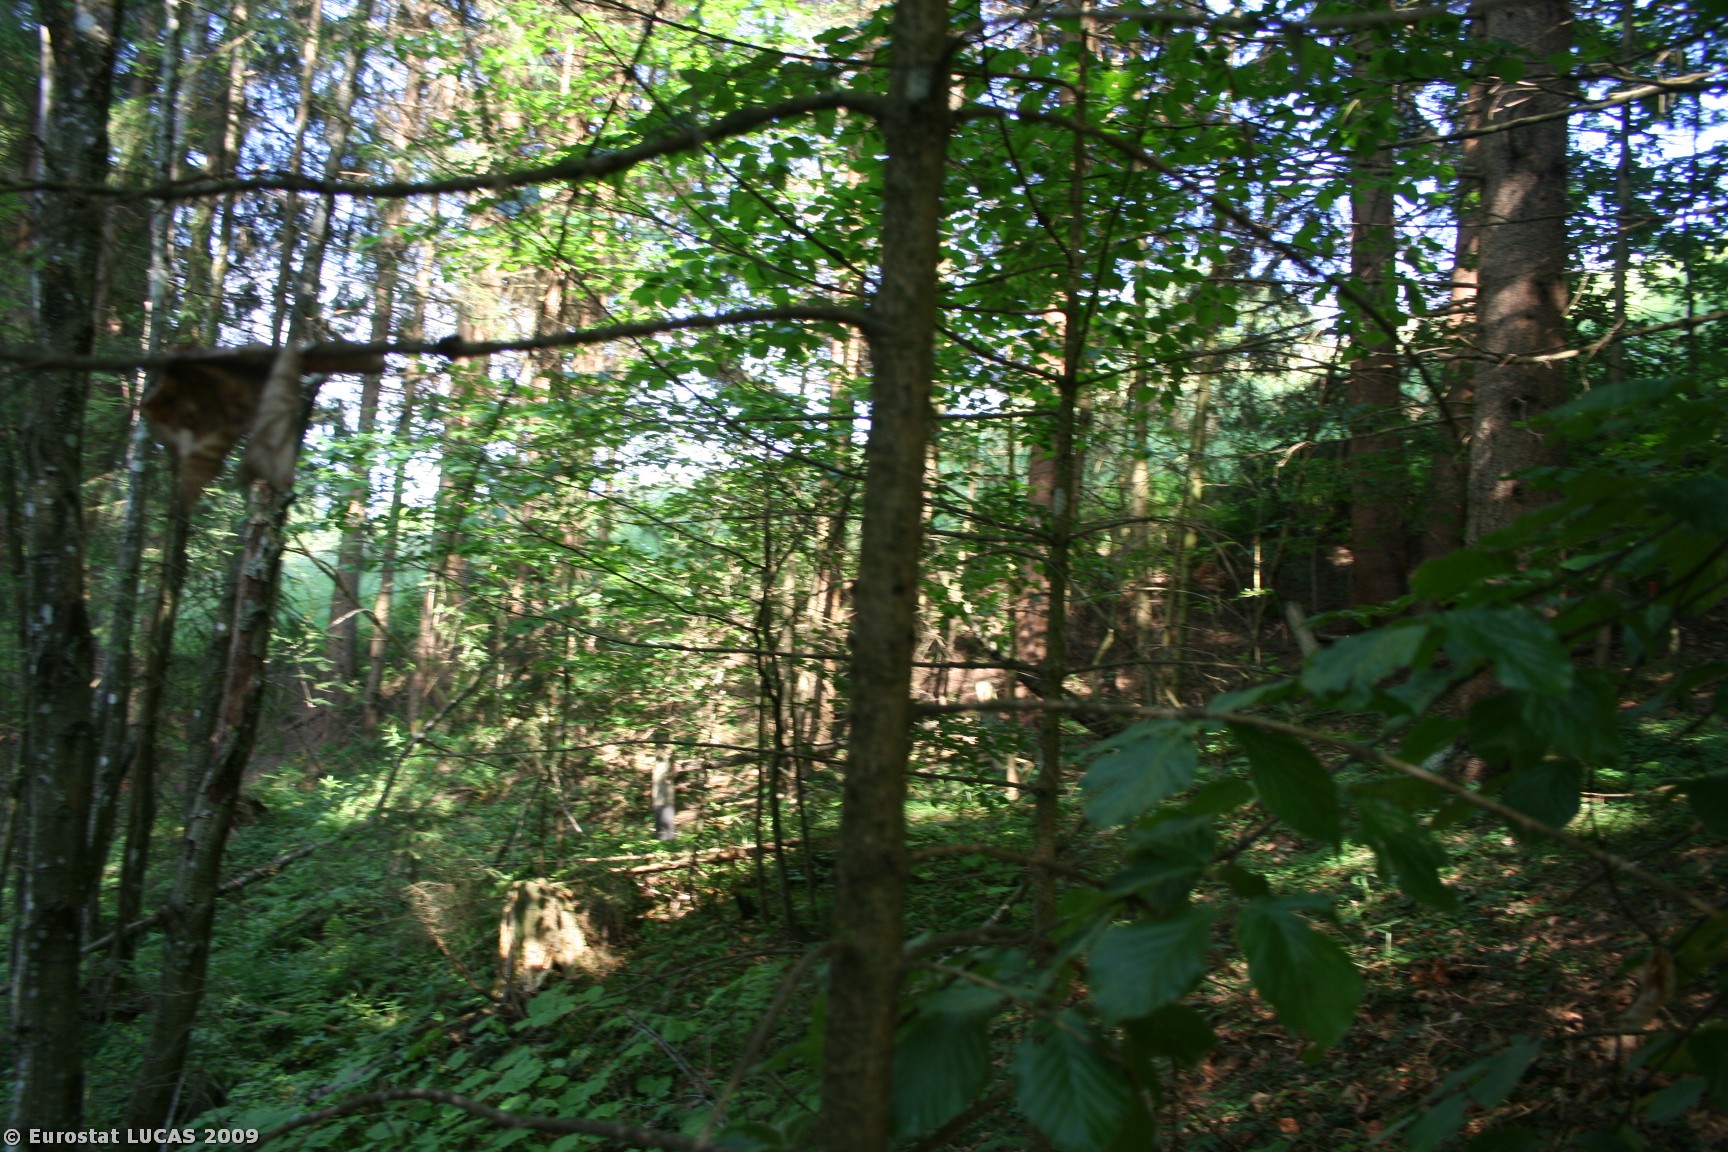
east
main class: Woodland
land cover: Mixed woodland
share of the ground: > 75 %
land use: Forestry
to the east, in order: Mixed woodland; Grassland without tree/shrub cover; Broadleaved woodland; Grassland without tree/shrub cover; Fences; Paved roads, cycling and walking lanes; Fences; Grassland with sparse tree/shrub cover; Ditches and canals; Grassland with sparse tree/shrub cover
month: June
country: AT
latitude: 47.4185
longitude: 13.2721
